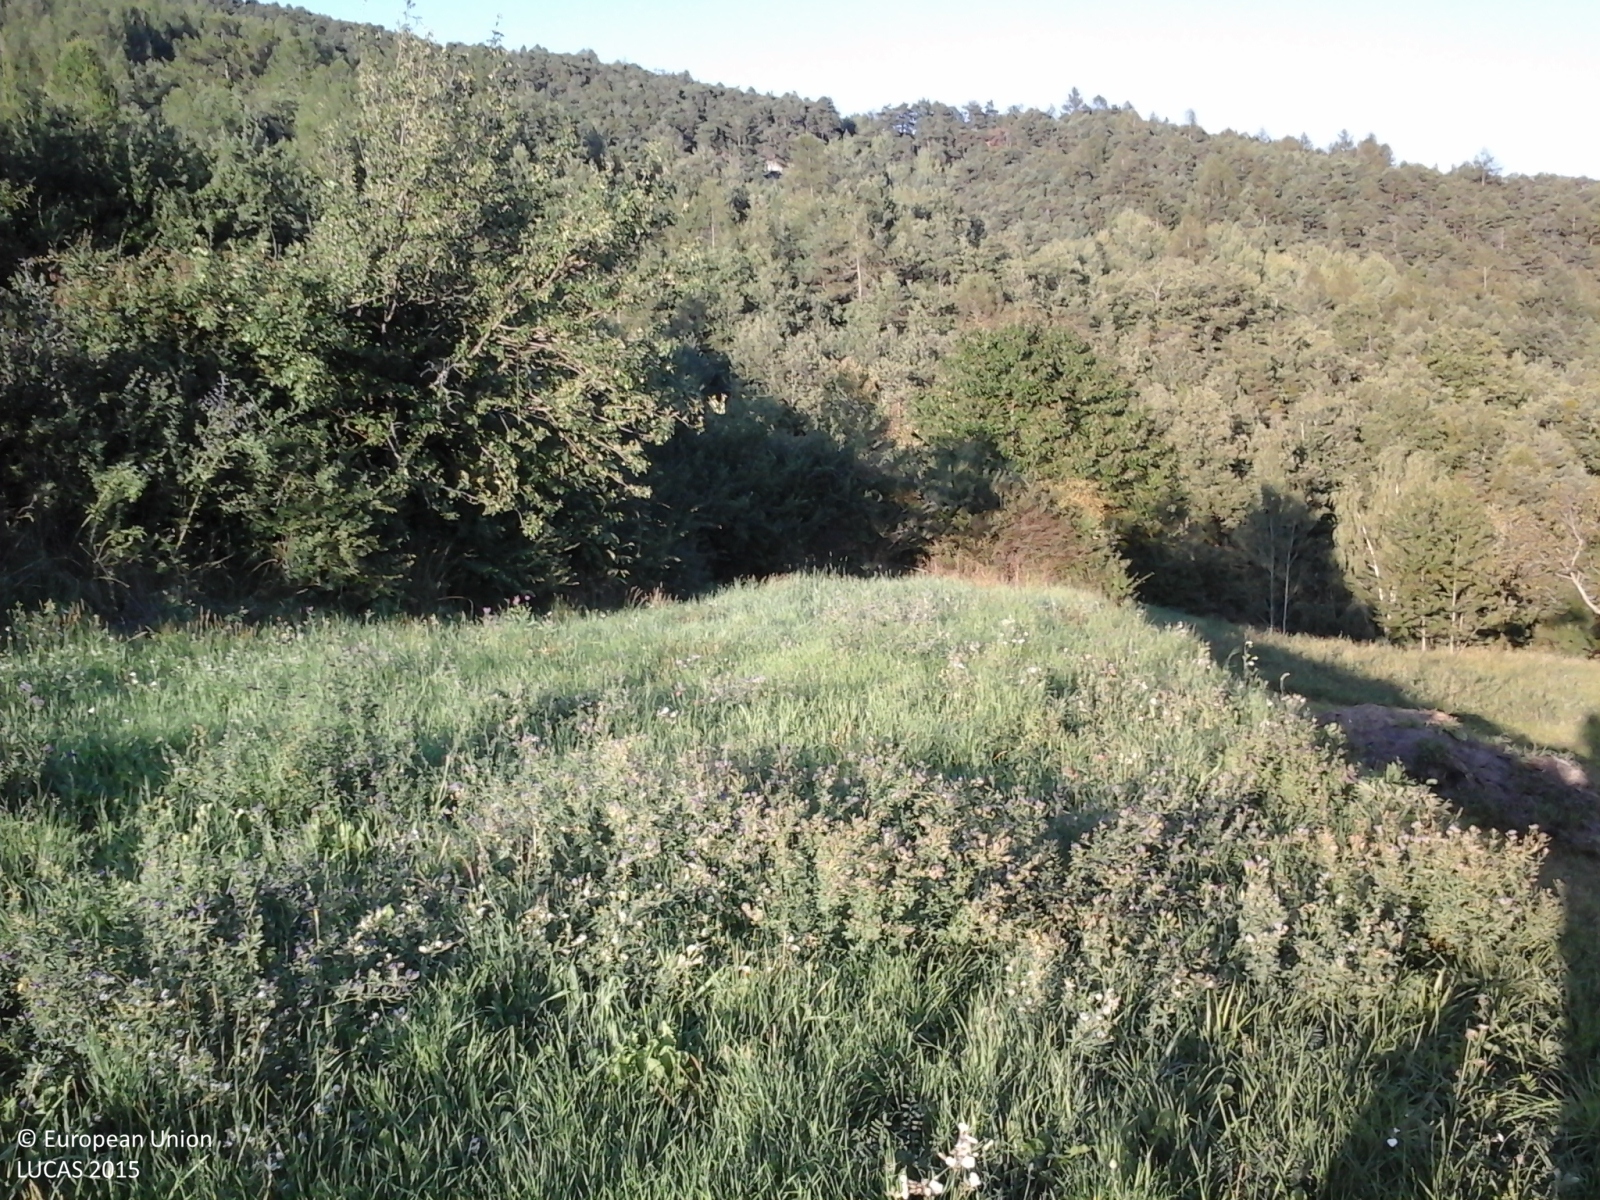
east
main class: Grassland
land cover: Grassland without tree/shrub cover
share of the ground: > 75 %
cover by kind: herbaceous plants 95 %, shrubs 5 %
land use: Agriculture (excluding fallow land and kitchen gardens)
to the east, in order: Grassland without tree/shrub cover; Broadleaved woodland; Grassland without tree/shrub cover; Ditches and canals; Pine dominated mixed woodland; Tracks; Pine dominated mixed woodland; Tracks; Dry stone walls; Grassland with sparse tree/shrub cover; Ditches and canals; Pine dominated mixed woodland; Tracks; Dry stone walls; Pine dominated mixed woodland
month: August
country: IT
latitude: 45.7644
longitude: 7.5476
